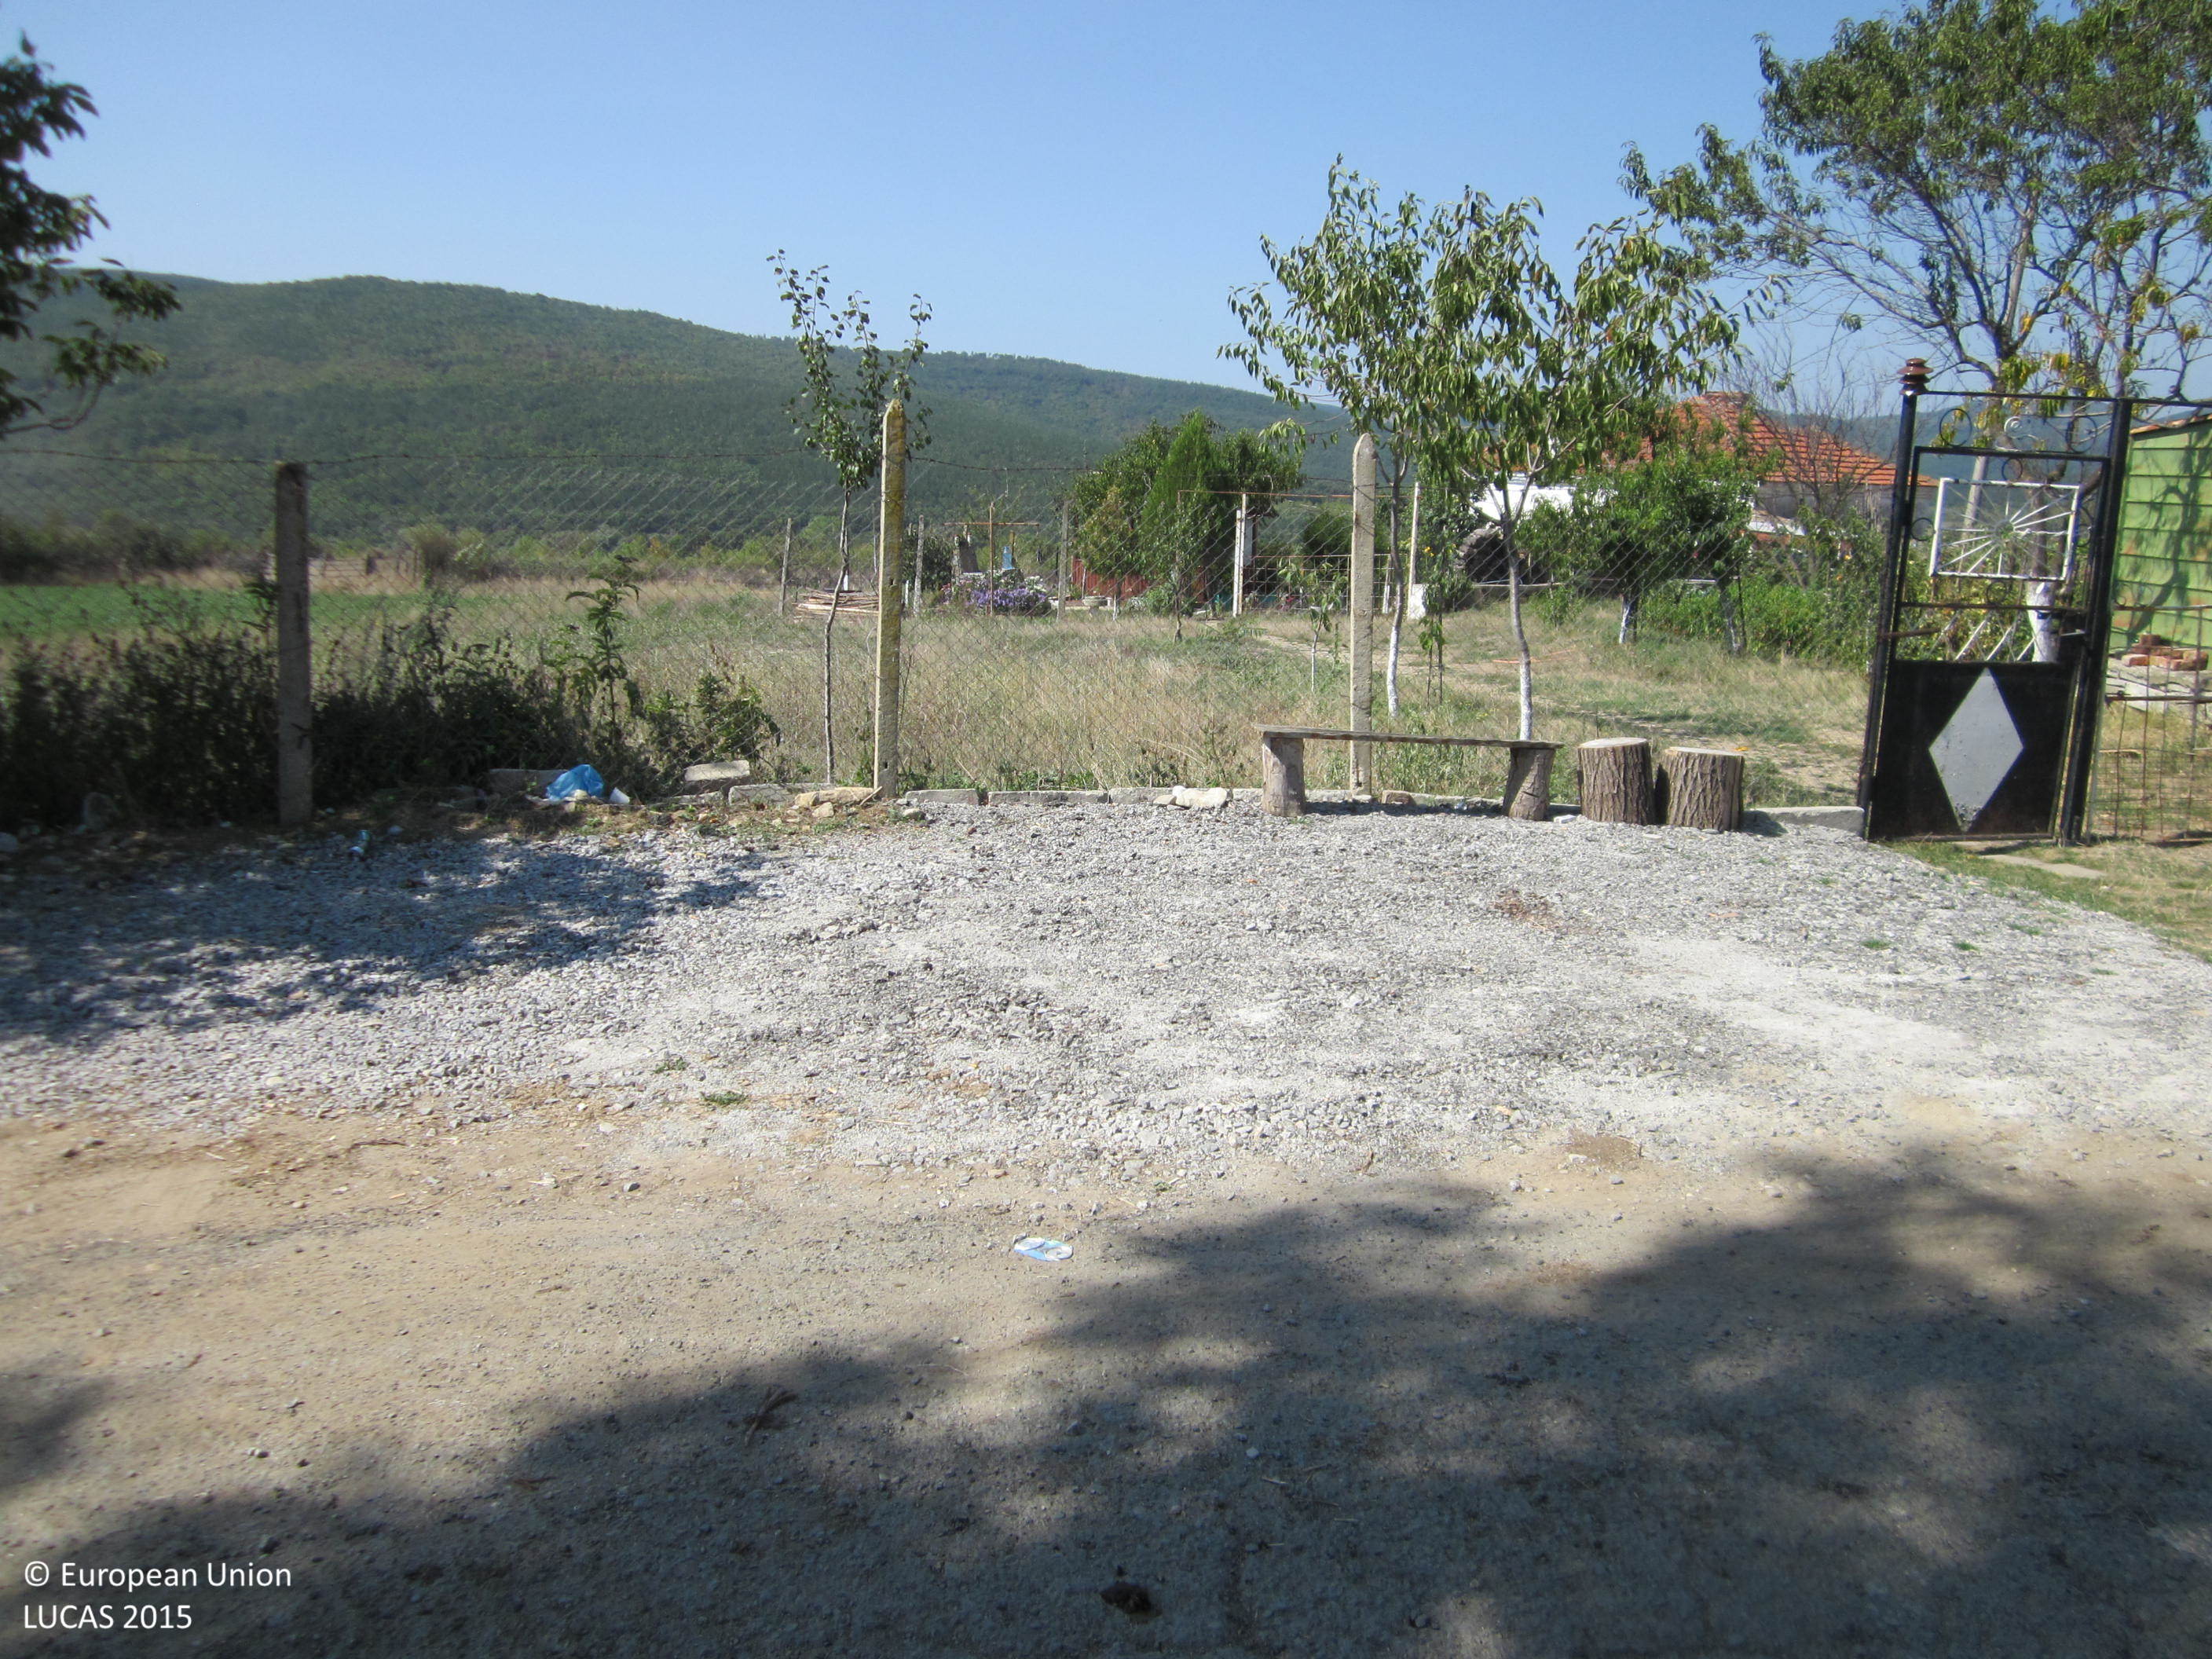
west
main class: Grassland
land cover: Grassland with sparse tree/shrub cover
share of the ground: > 75 %
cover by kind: herbaceous plants 80 %, unconsolidated bare surface 10 %, broadleaved forest trees 5 %, shrubs 5 %
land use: Residential
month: September
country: BG
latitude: 42.8853
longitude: 26.9688
